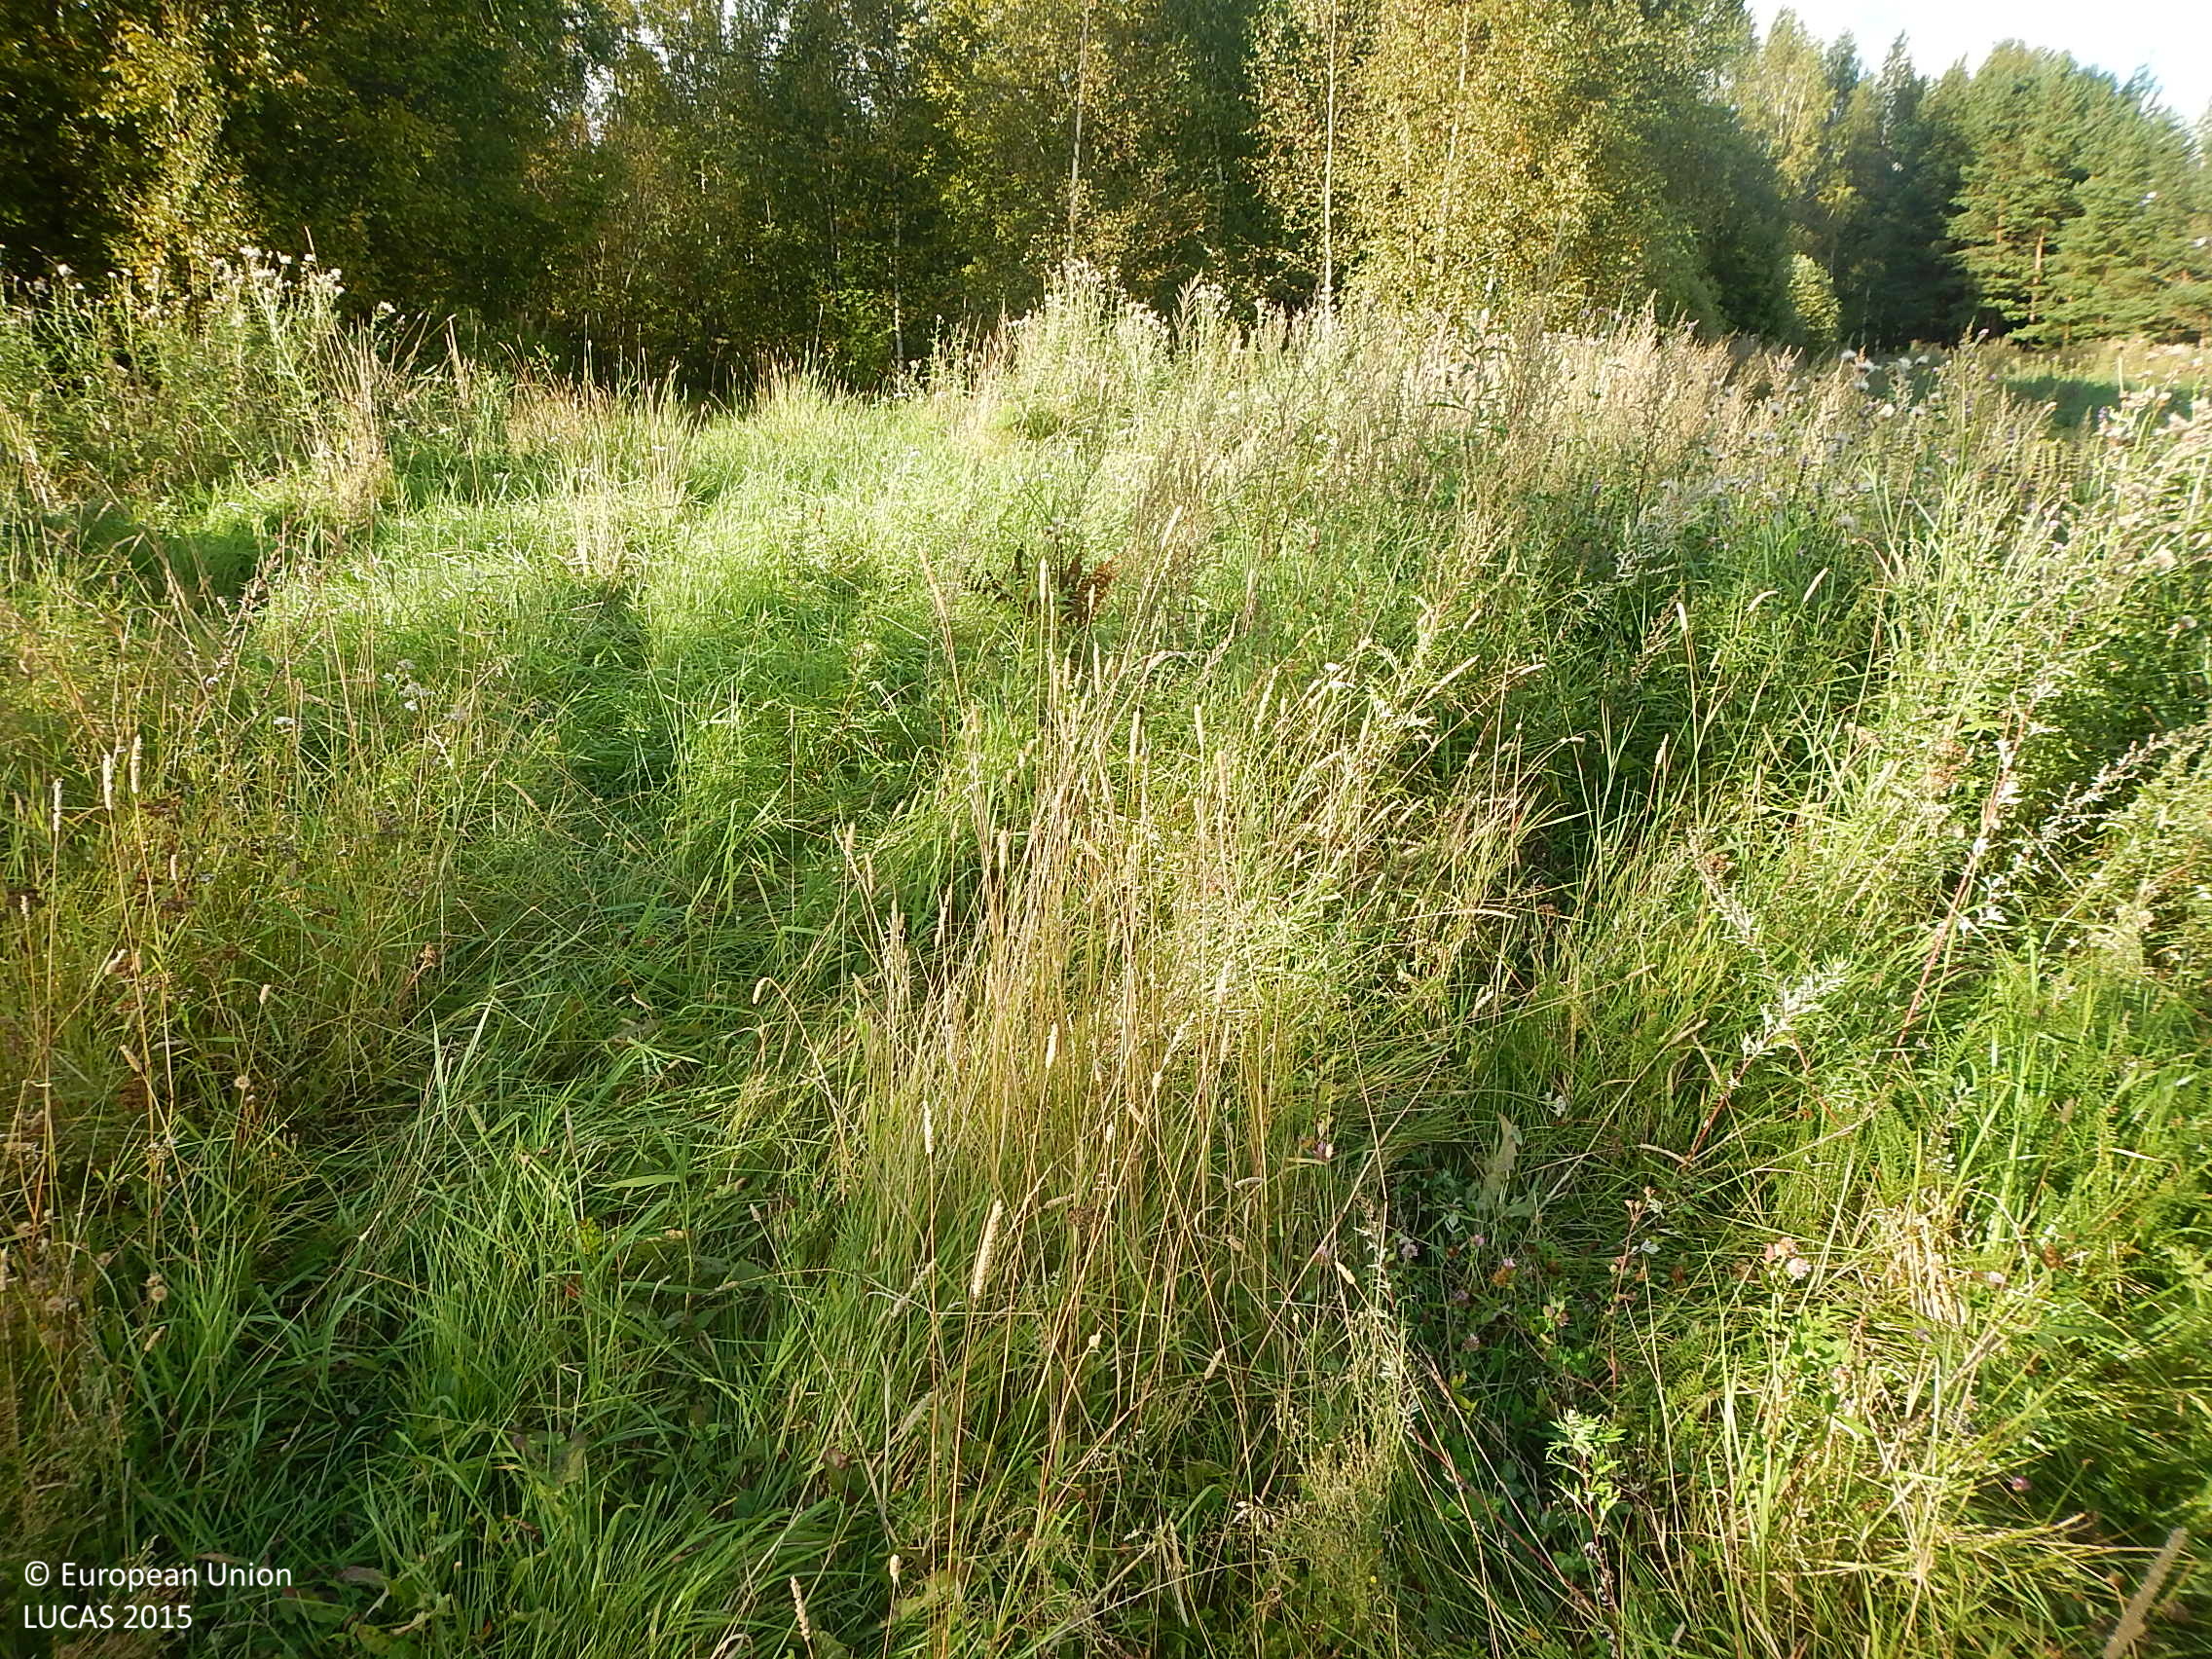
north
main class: Grassland
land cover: Spontaneously vegetated surfaces
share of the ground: > 75 %
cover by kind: herbaceous plants 100 %
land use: Fallow land
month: September
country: FI
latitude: 61.5011
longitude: 22.1006
